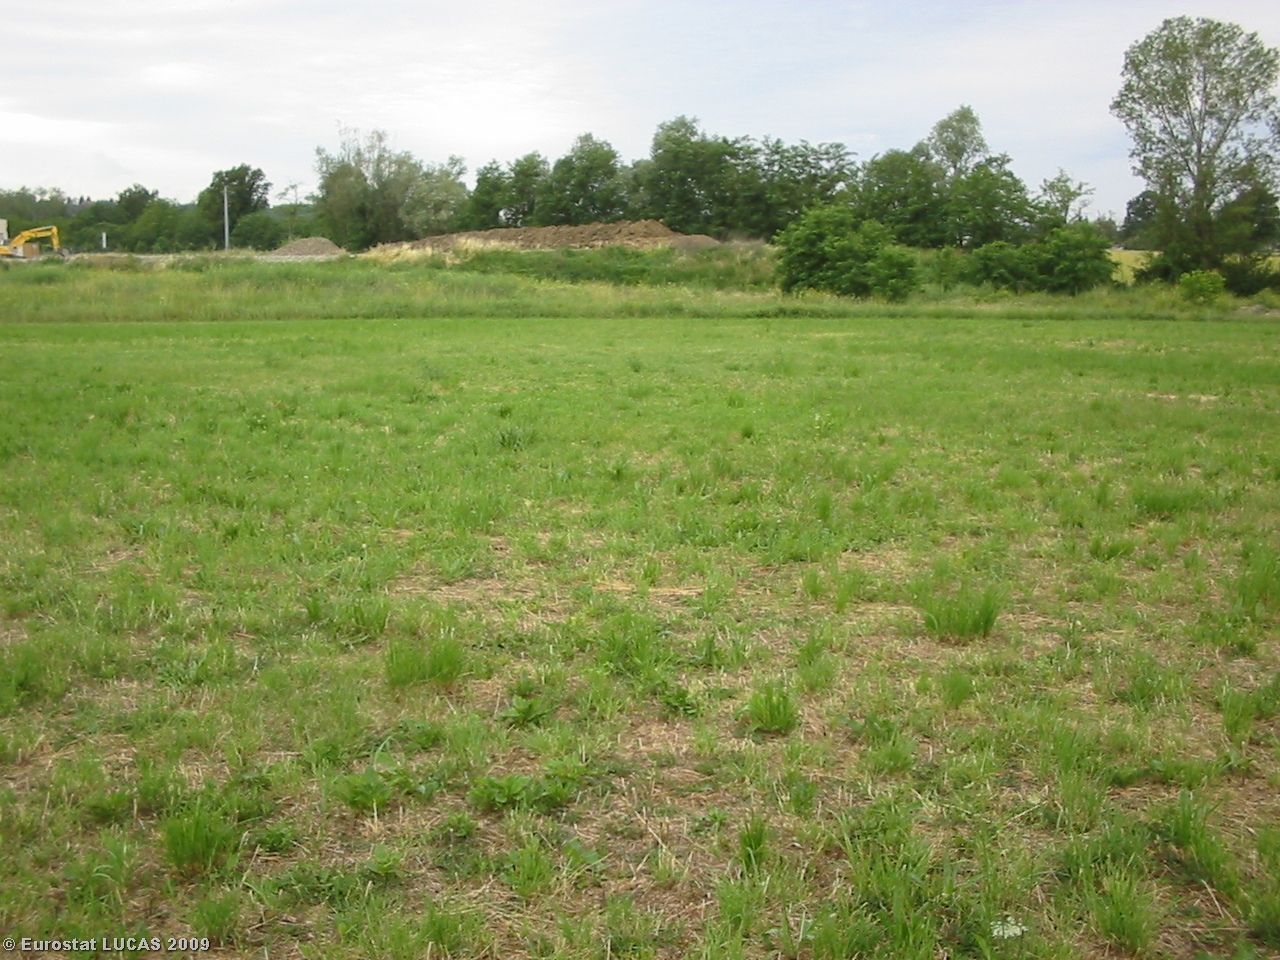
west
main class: Grassland
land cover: Grassland without tree/shrub cover
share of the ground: > 75 %
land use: Agriculture (excluding fallow land and kitchen gardens)
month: June
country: IT
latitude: 44.6929
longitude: 10.2644
